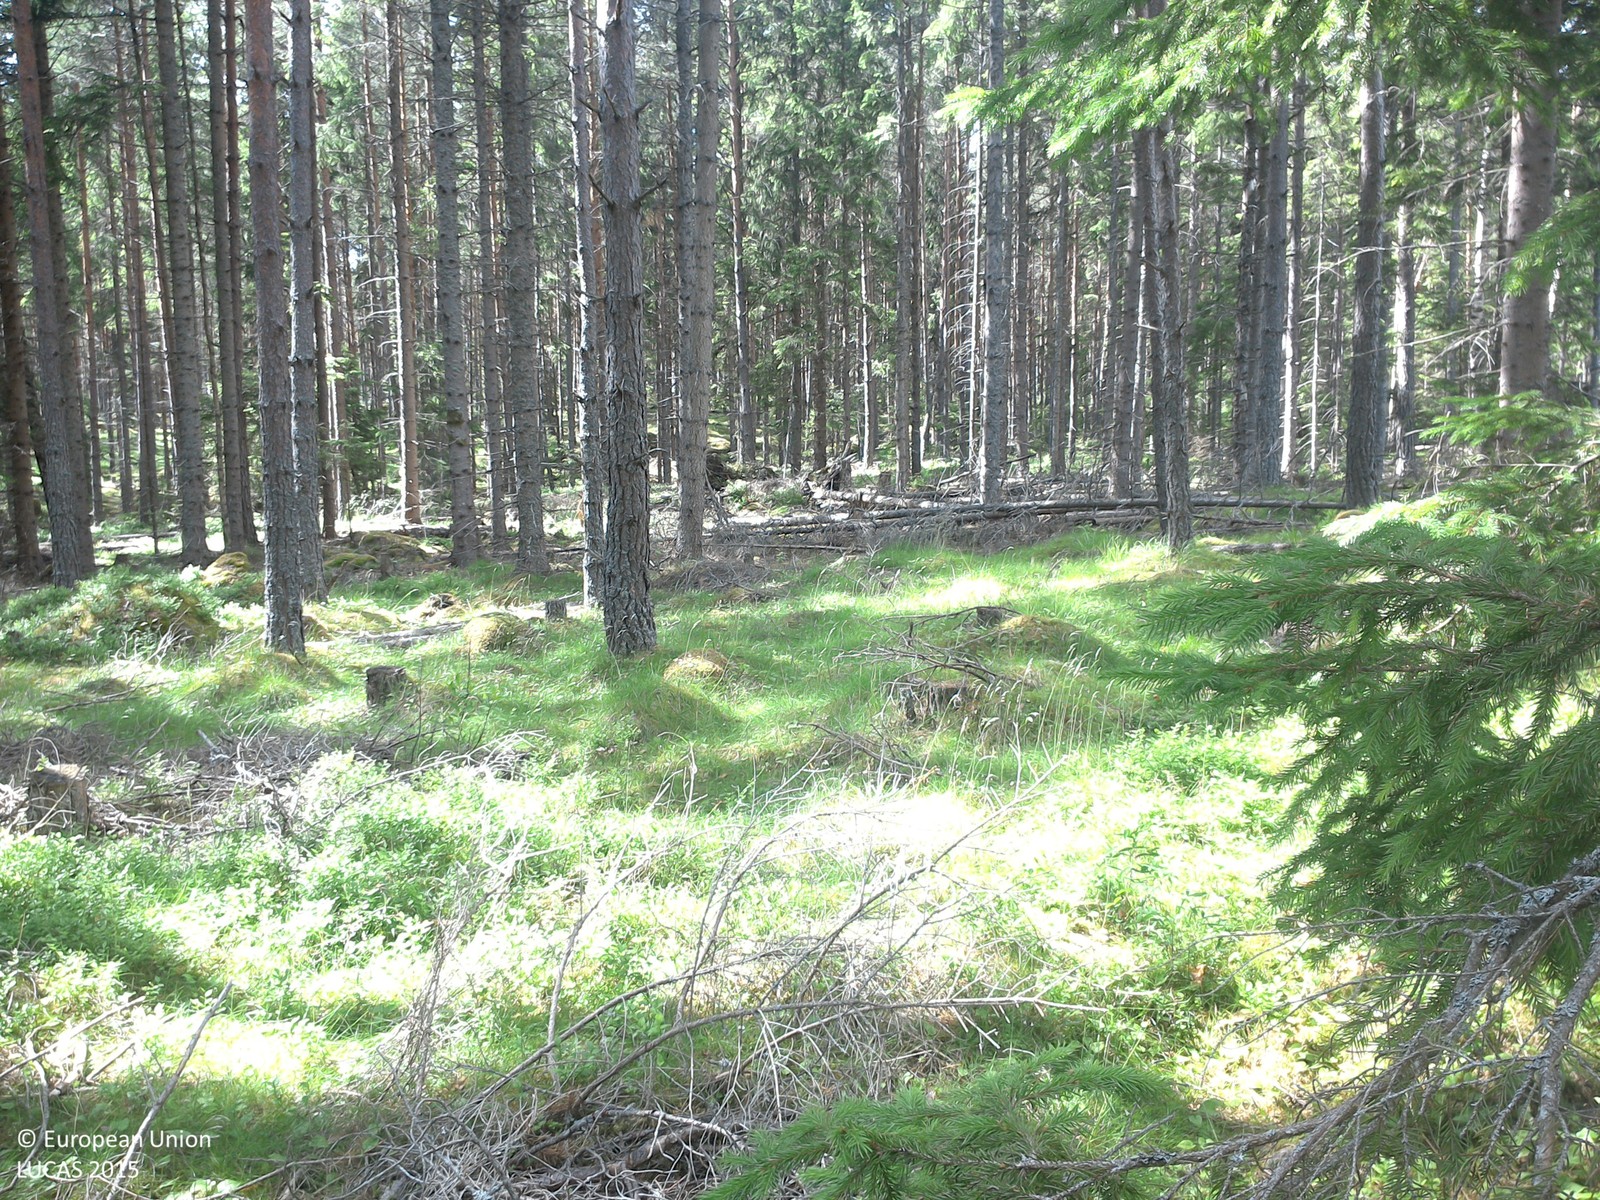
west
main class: Woodland
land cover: Pine dominated coniferous woodland
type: boreal forest
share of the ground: 50 - 75 %
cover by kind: coniferous forest trees 65 %, lichens and mosses 30 %, herbaceous plants 5 %
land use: Forestry
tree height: > 5 m
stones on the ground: < 10 %
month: June
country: SE
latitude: 58.0528
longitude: 15.5023
